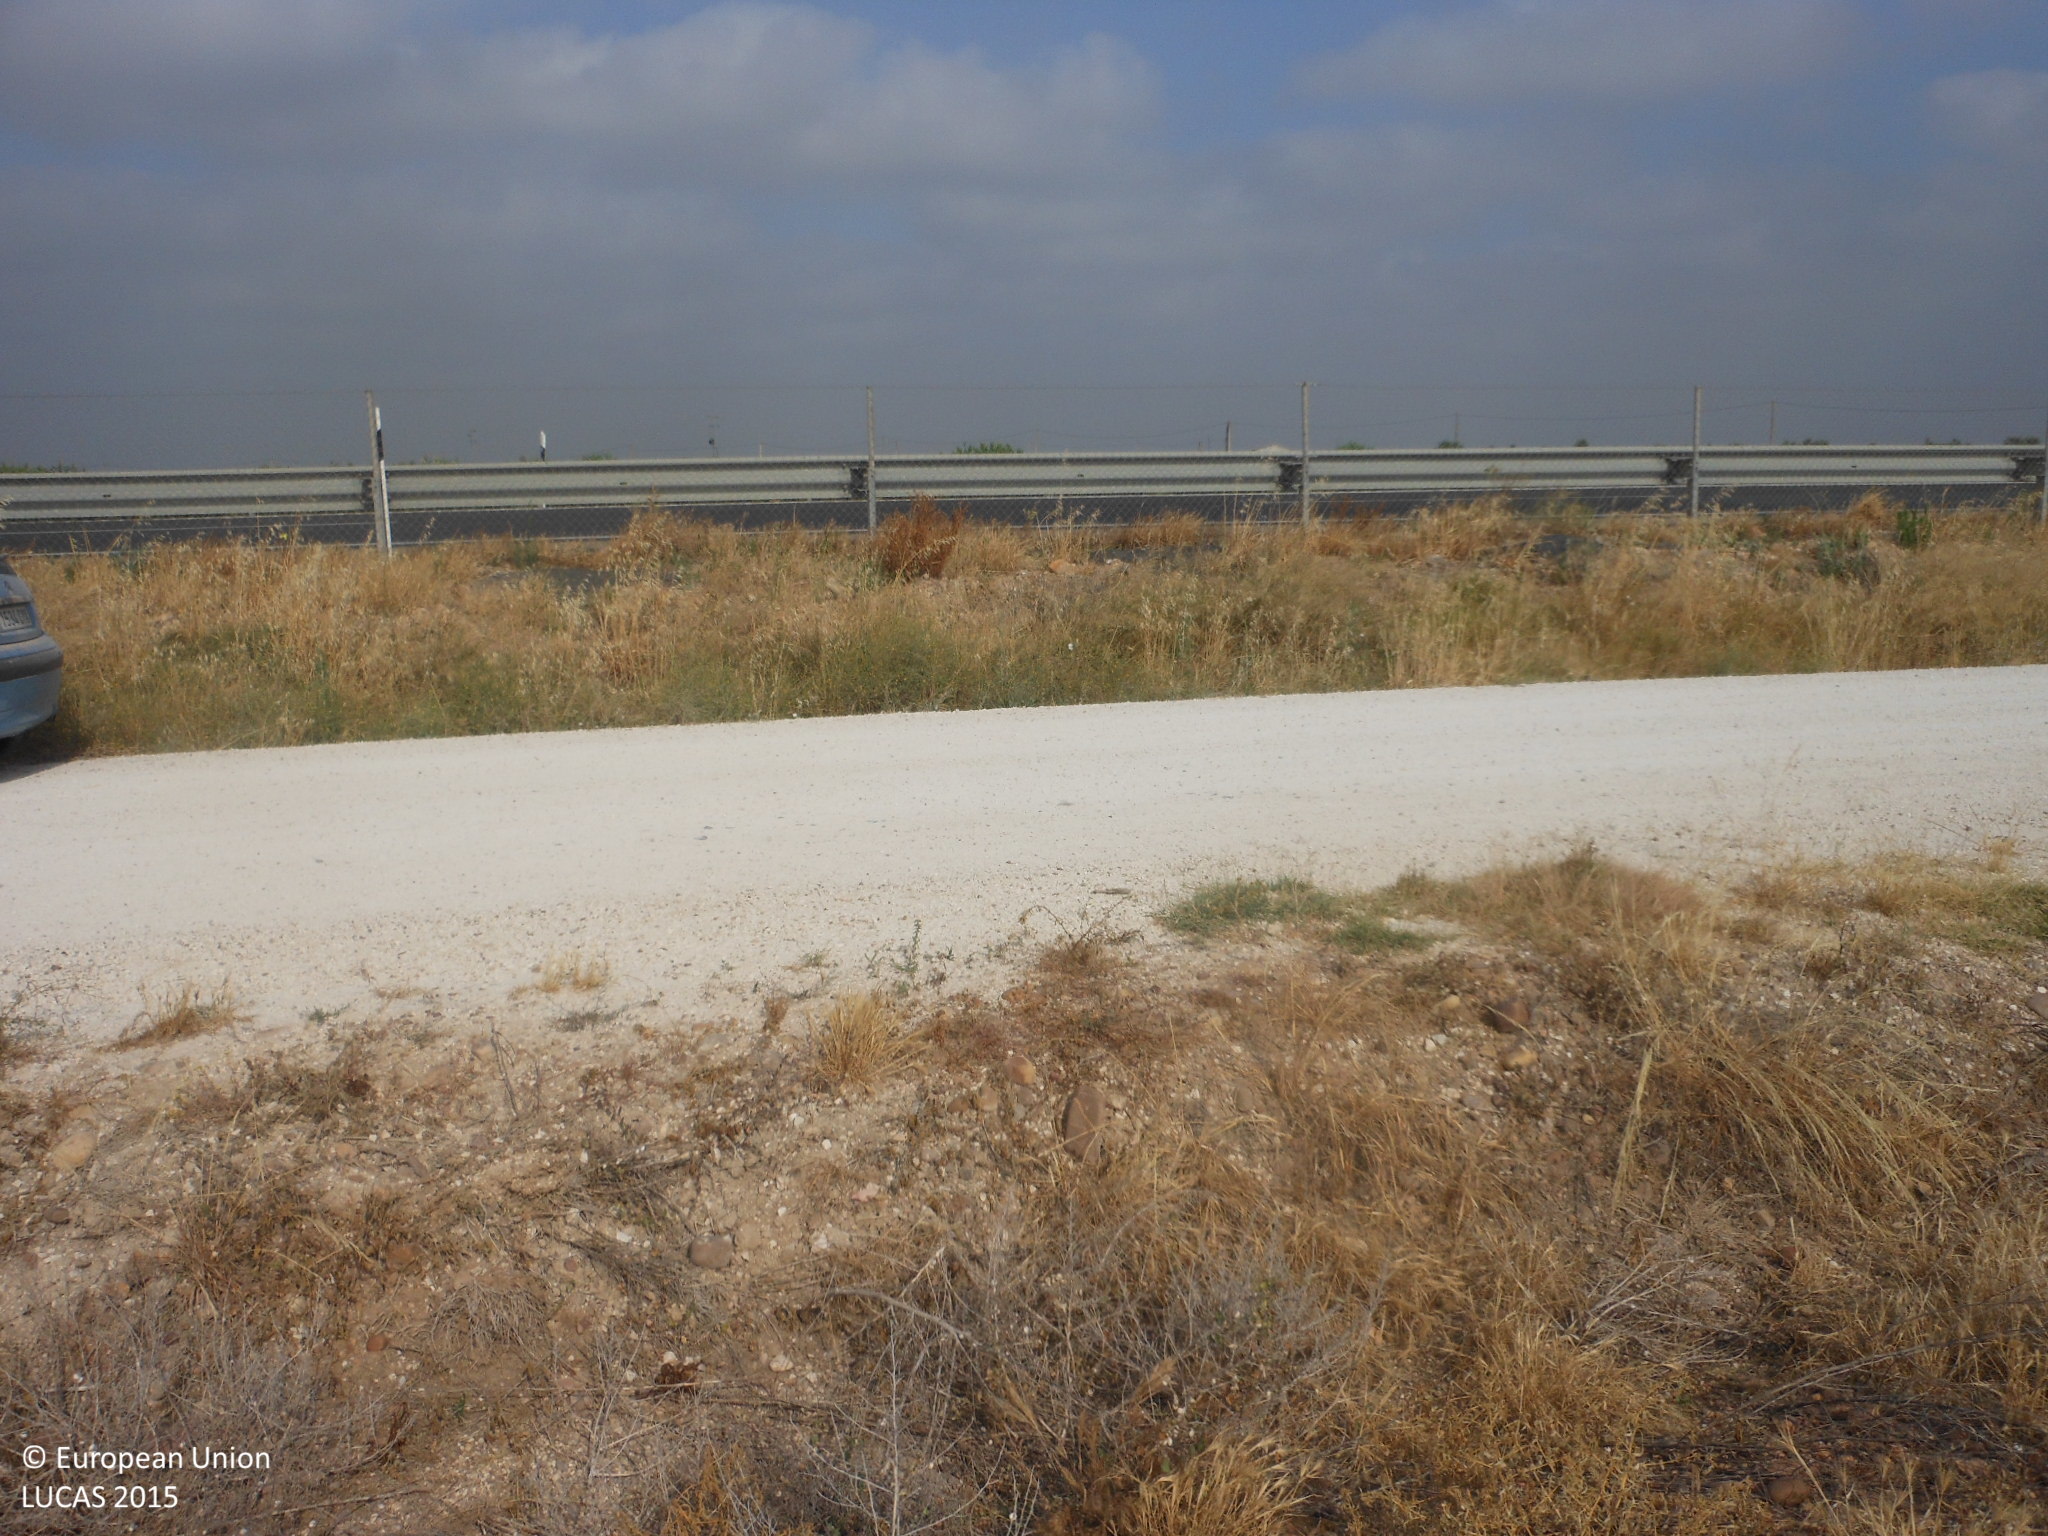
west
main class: Cropland
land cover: Olive groves
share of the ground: 50 - 75 %
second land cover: Other bare soil
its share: > 75 %
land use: Agriculture (excluding fallow land and kitchen gardens)
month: June
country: ES
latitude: 37.6246
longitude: -4.9572
